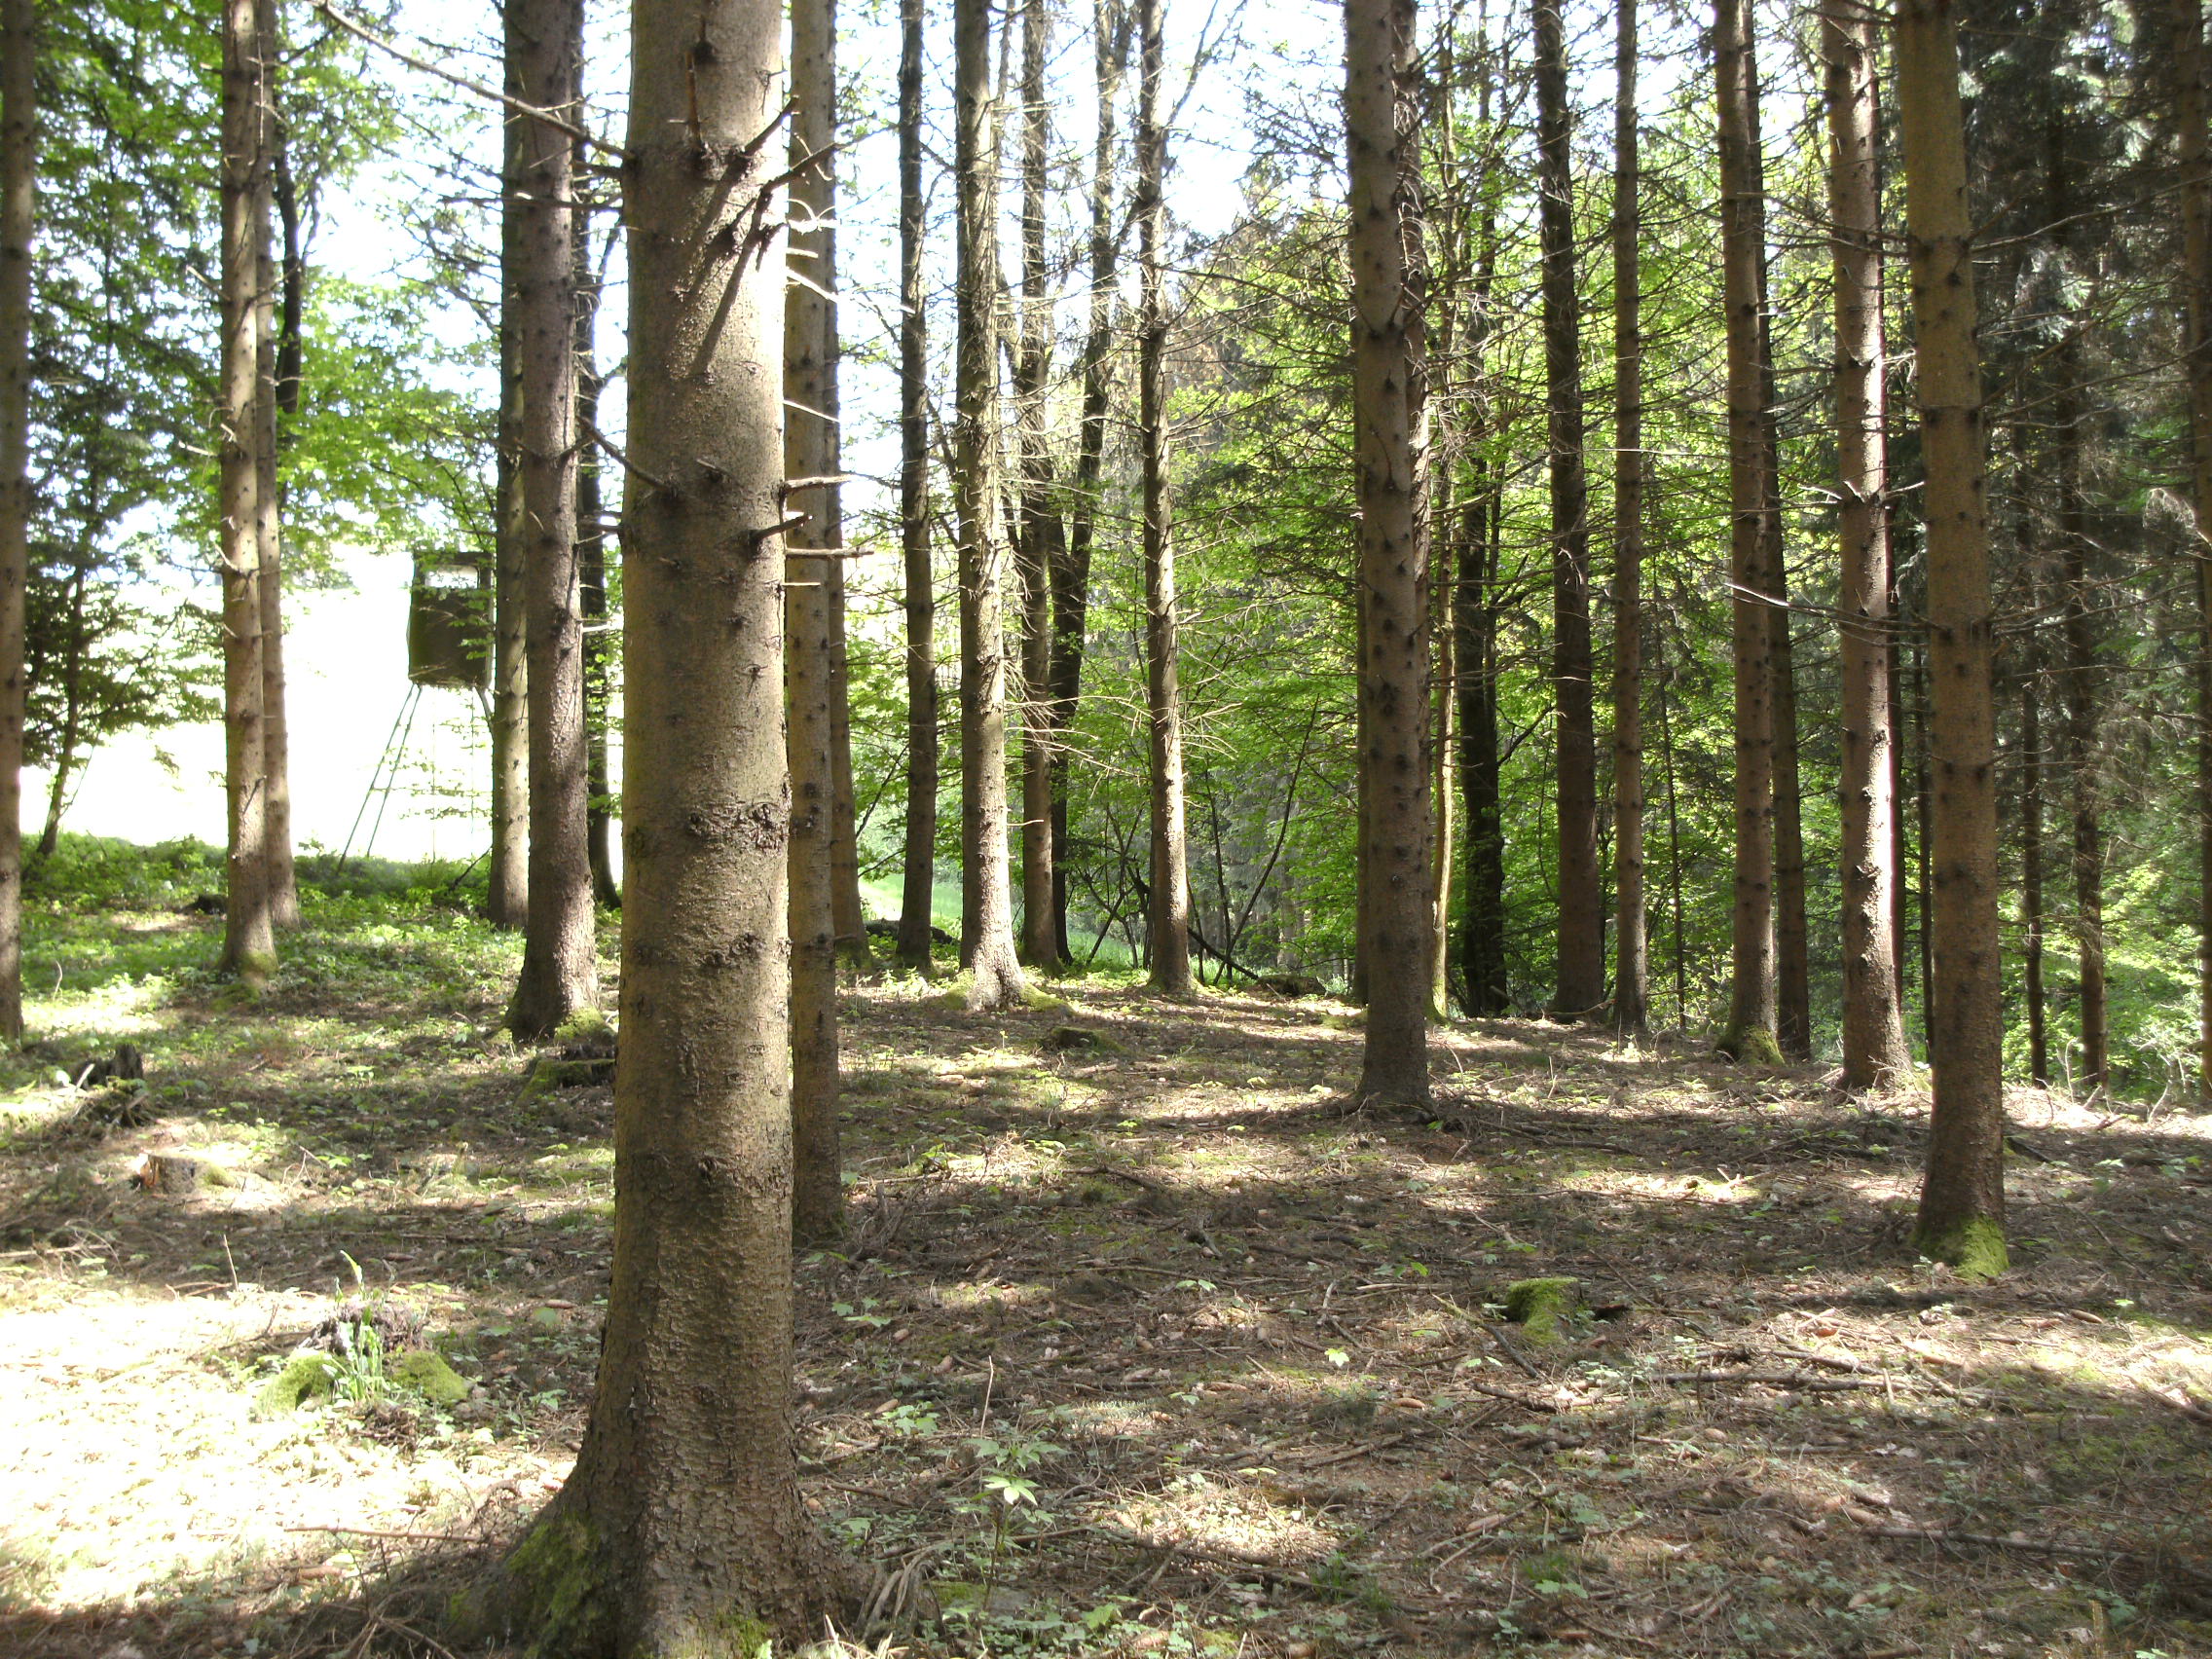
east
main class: Woodland
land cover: Spruce dominated coniferous woodland
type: hemiboreal forest and nemoral coniferous forest and mixed broadleaved-coniferous forest
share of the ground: > 75 %
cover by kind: coniferous forest trees 100 %
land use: Forestry
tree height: > 5 m
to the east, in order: Spruce dominated coniferous woodland; Tracks; Spruce dominated coniferous woodland; Broadleaved woodland; Grassland without tree/shrub cover
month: May
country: AT
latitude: 48.5297
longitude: 13.4527
